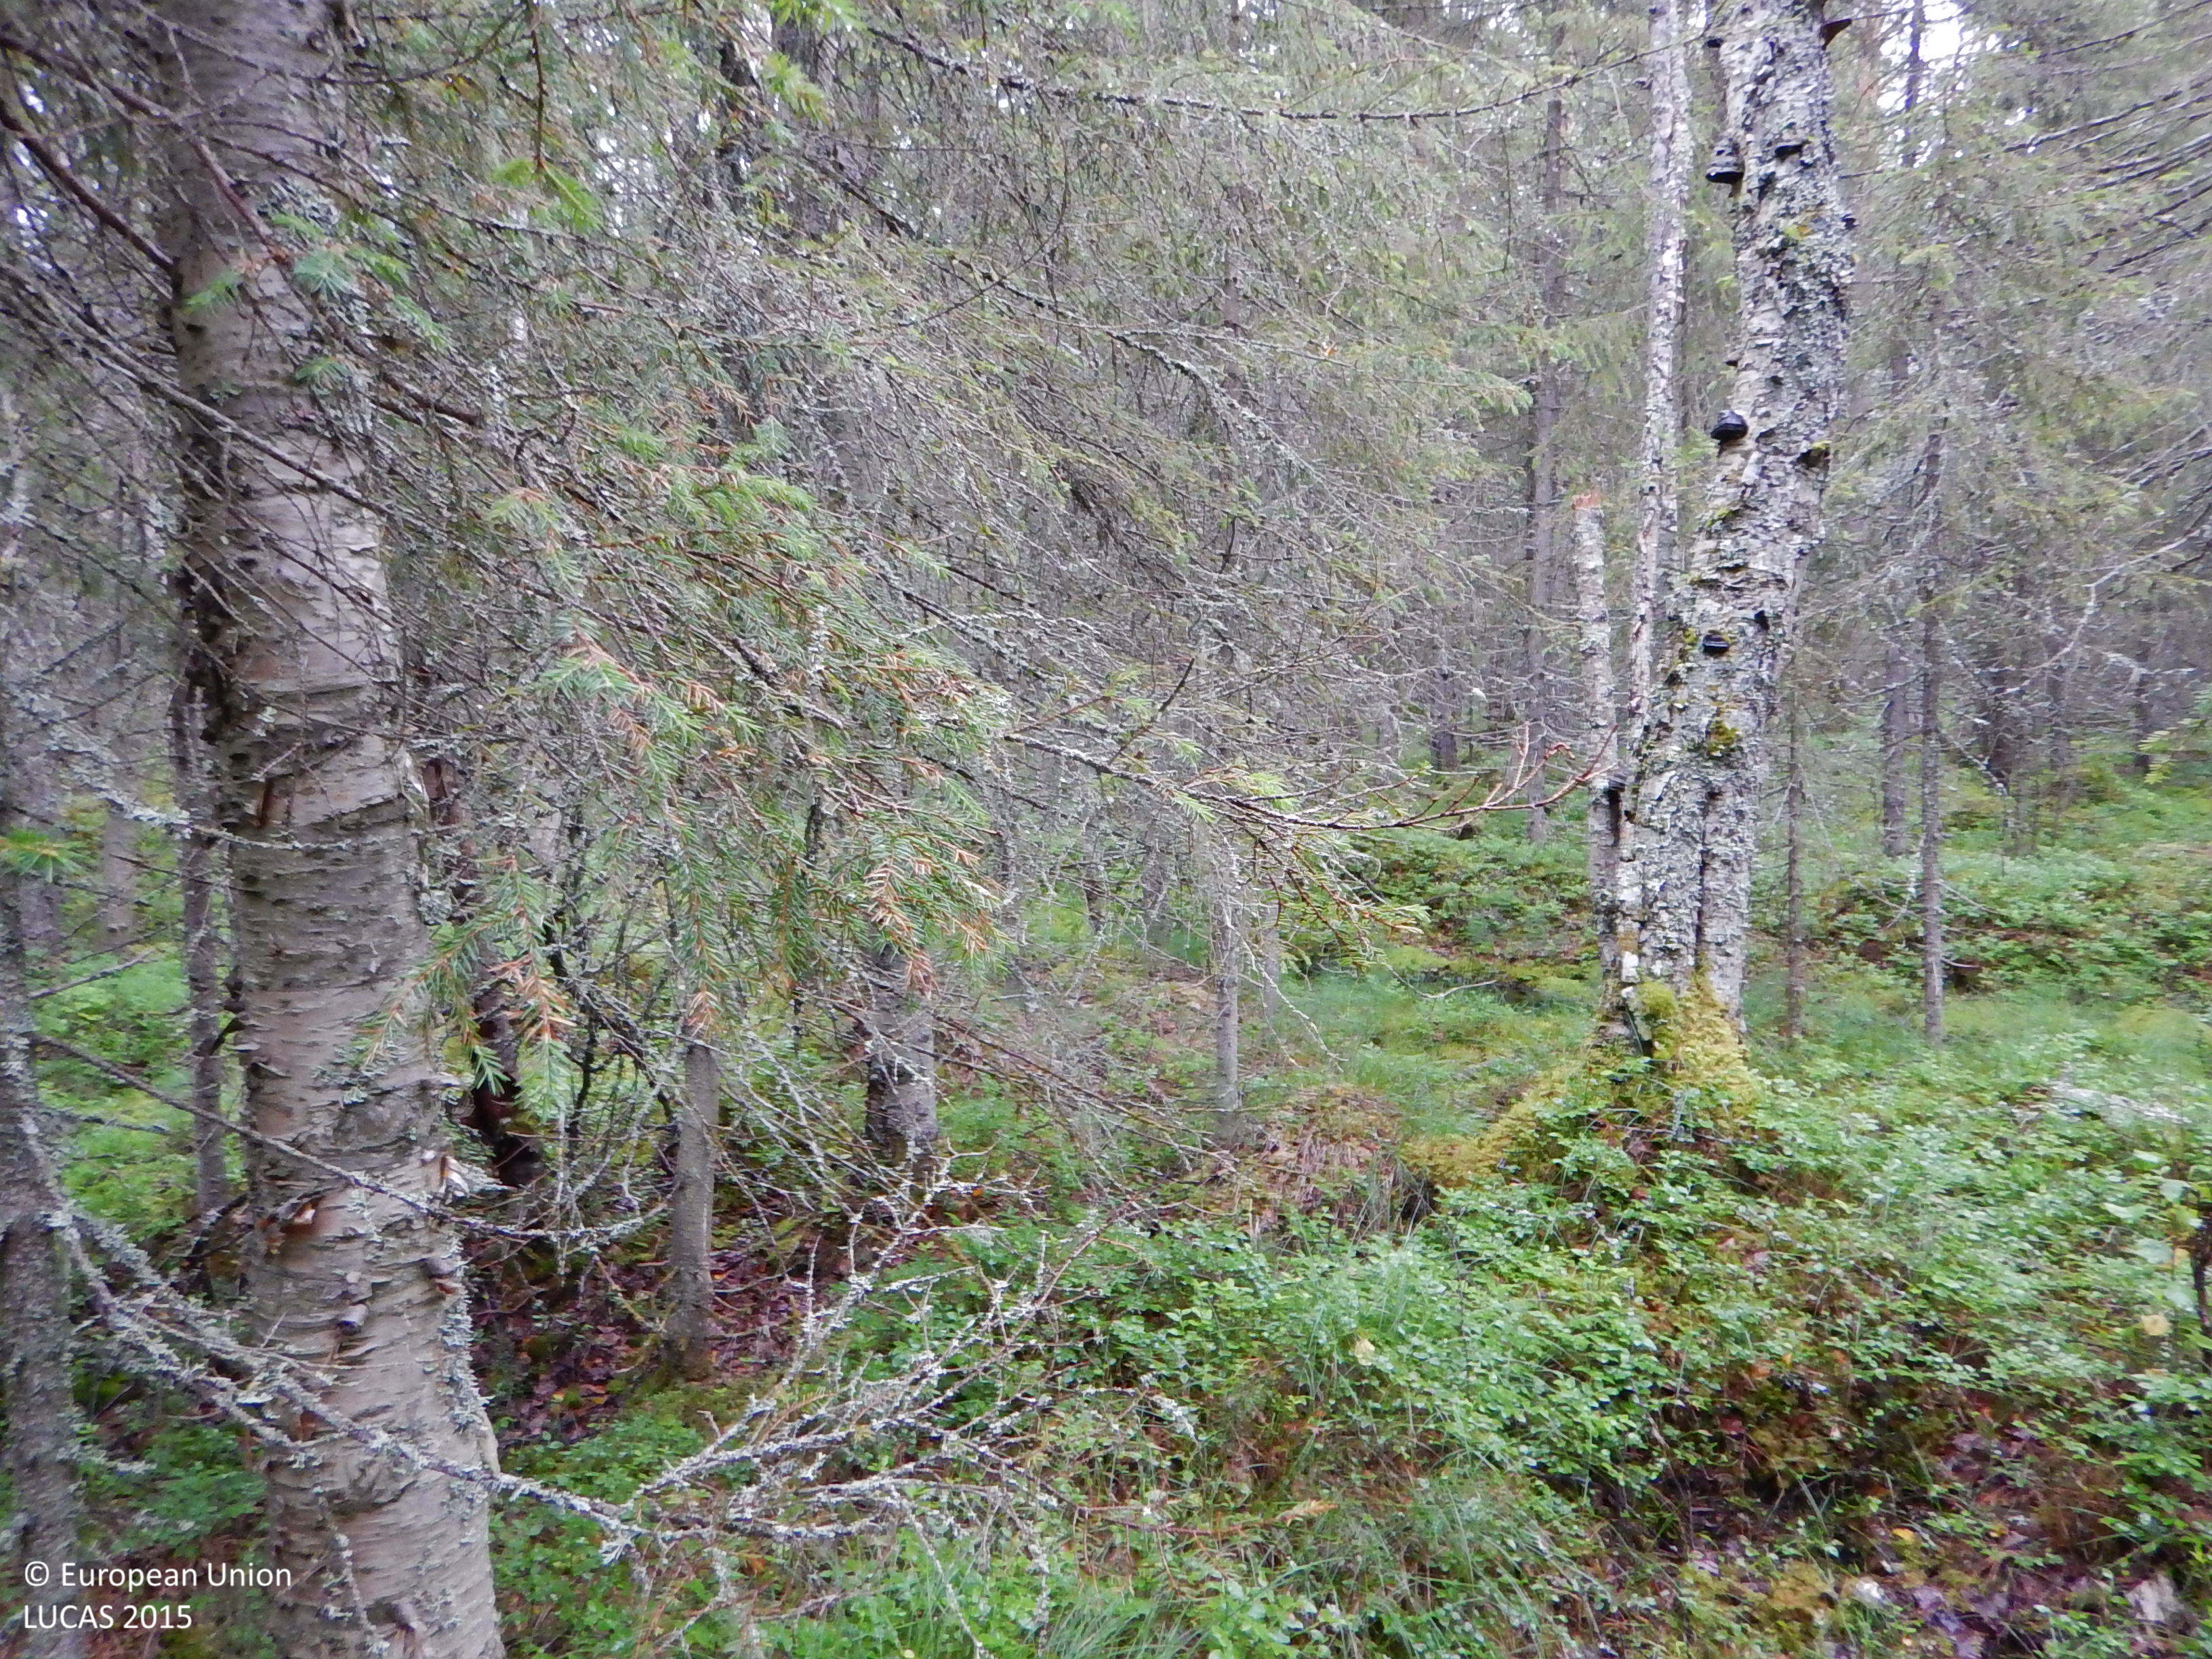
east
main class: Woodland
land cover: Spruce dominated mixed woodland
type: mire and swamp forests
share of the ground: 50 - 75 %
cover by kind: coniferous forest trees 45 %, broadleaved forest trees 15 %, shrubs 15 %, lichens and mosses 15 %, herbaceous plants 10 %
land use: Forestry
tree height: > 5 m
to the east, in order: Spruce dominated mixed woodland; Ditches and canals; Other mixed woodland; Pine dominated mixed woodland; Ditches and canals; Shrubland with sparse tree cover
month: July
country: SE
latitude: 65.0182
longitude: 20.4763
